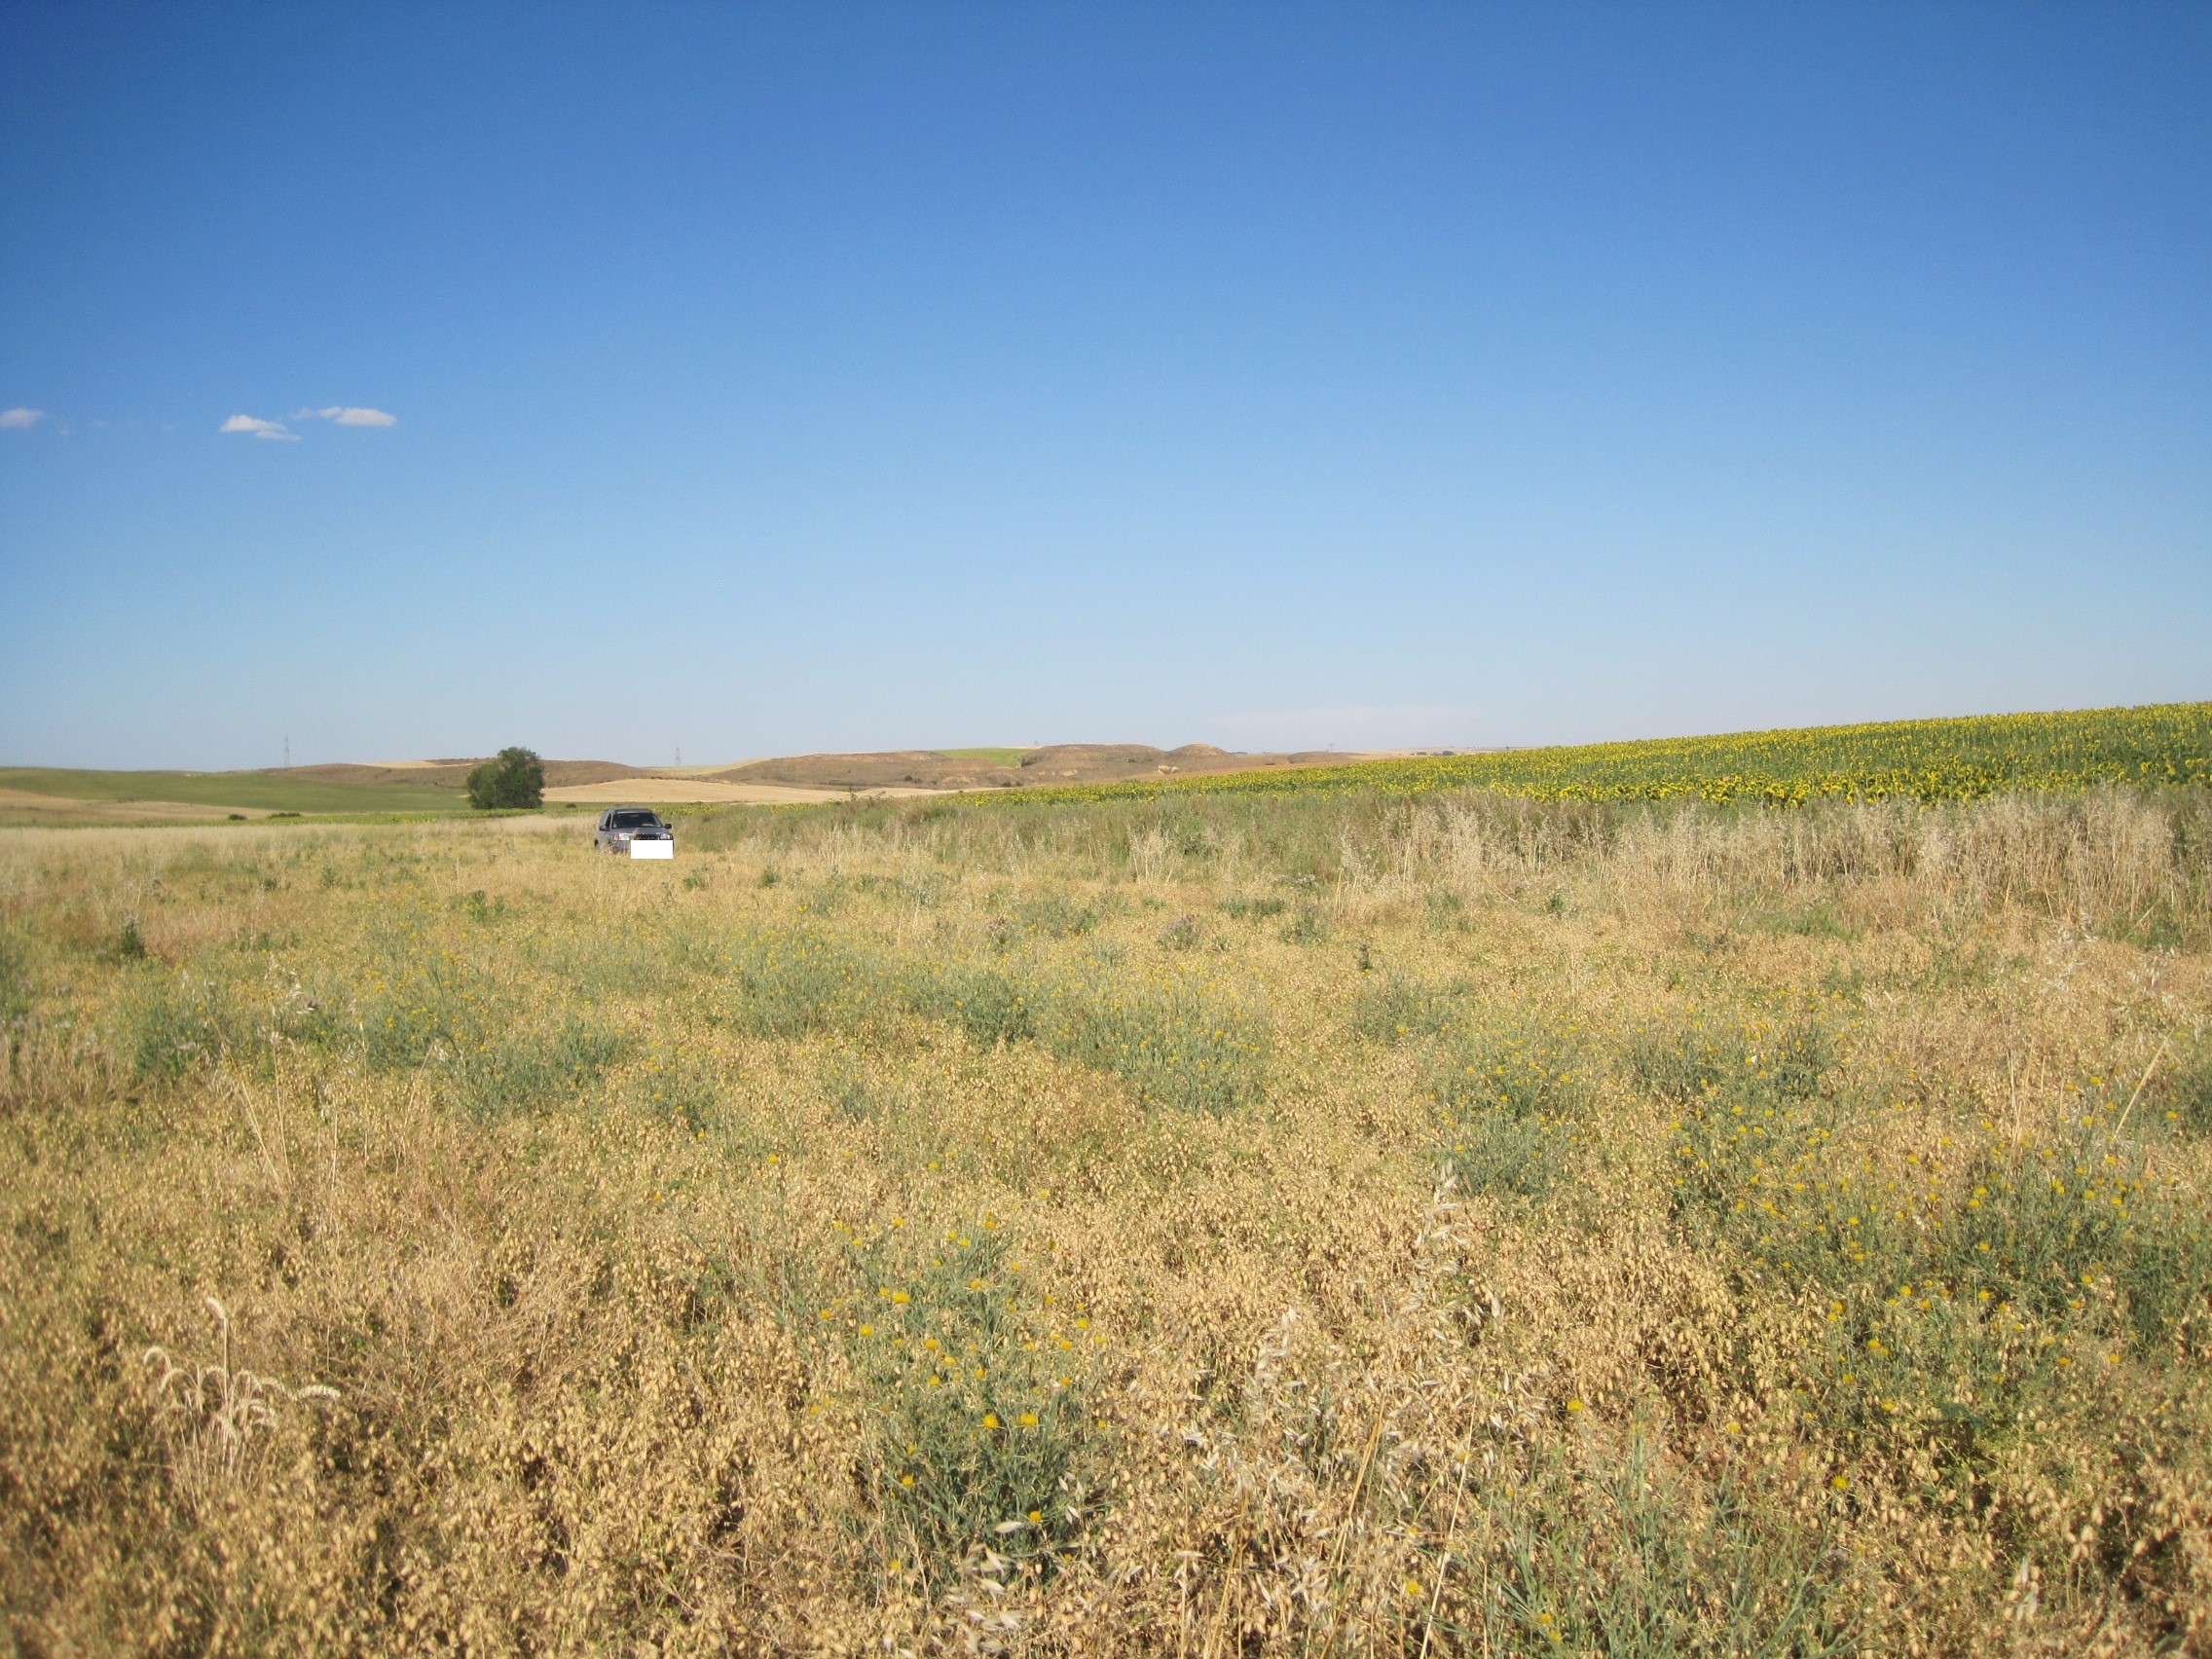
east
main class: Cropland
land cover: Dry pulses
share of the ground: > 75 %
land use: Agriculture (excluding fallow land and kitchen gardens)
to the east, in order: Dry pulses; Grass margins; Rivers and streams; Grass margins; Sunflower
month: July
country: ES
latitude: 42.1381
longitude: -5.2202
